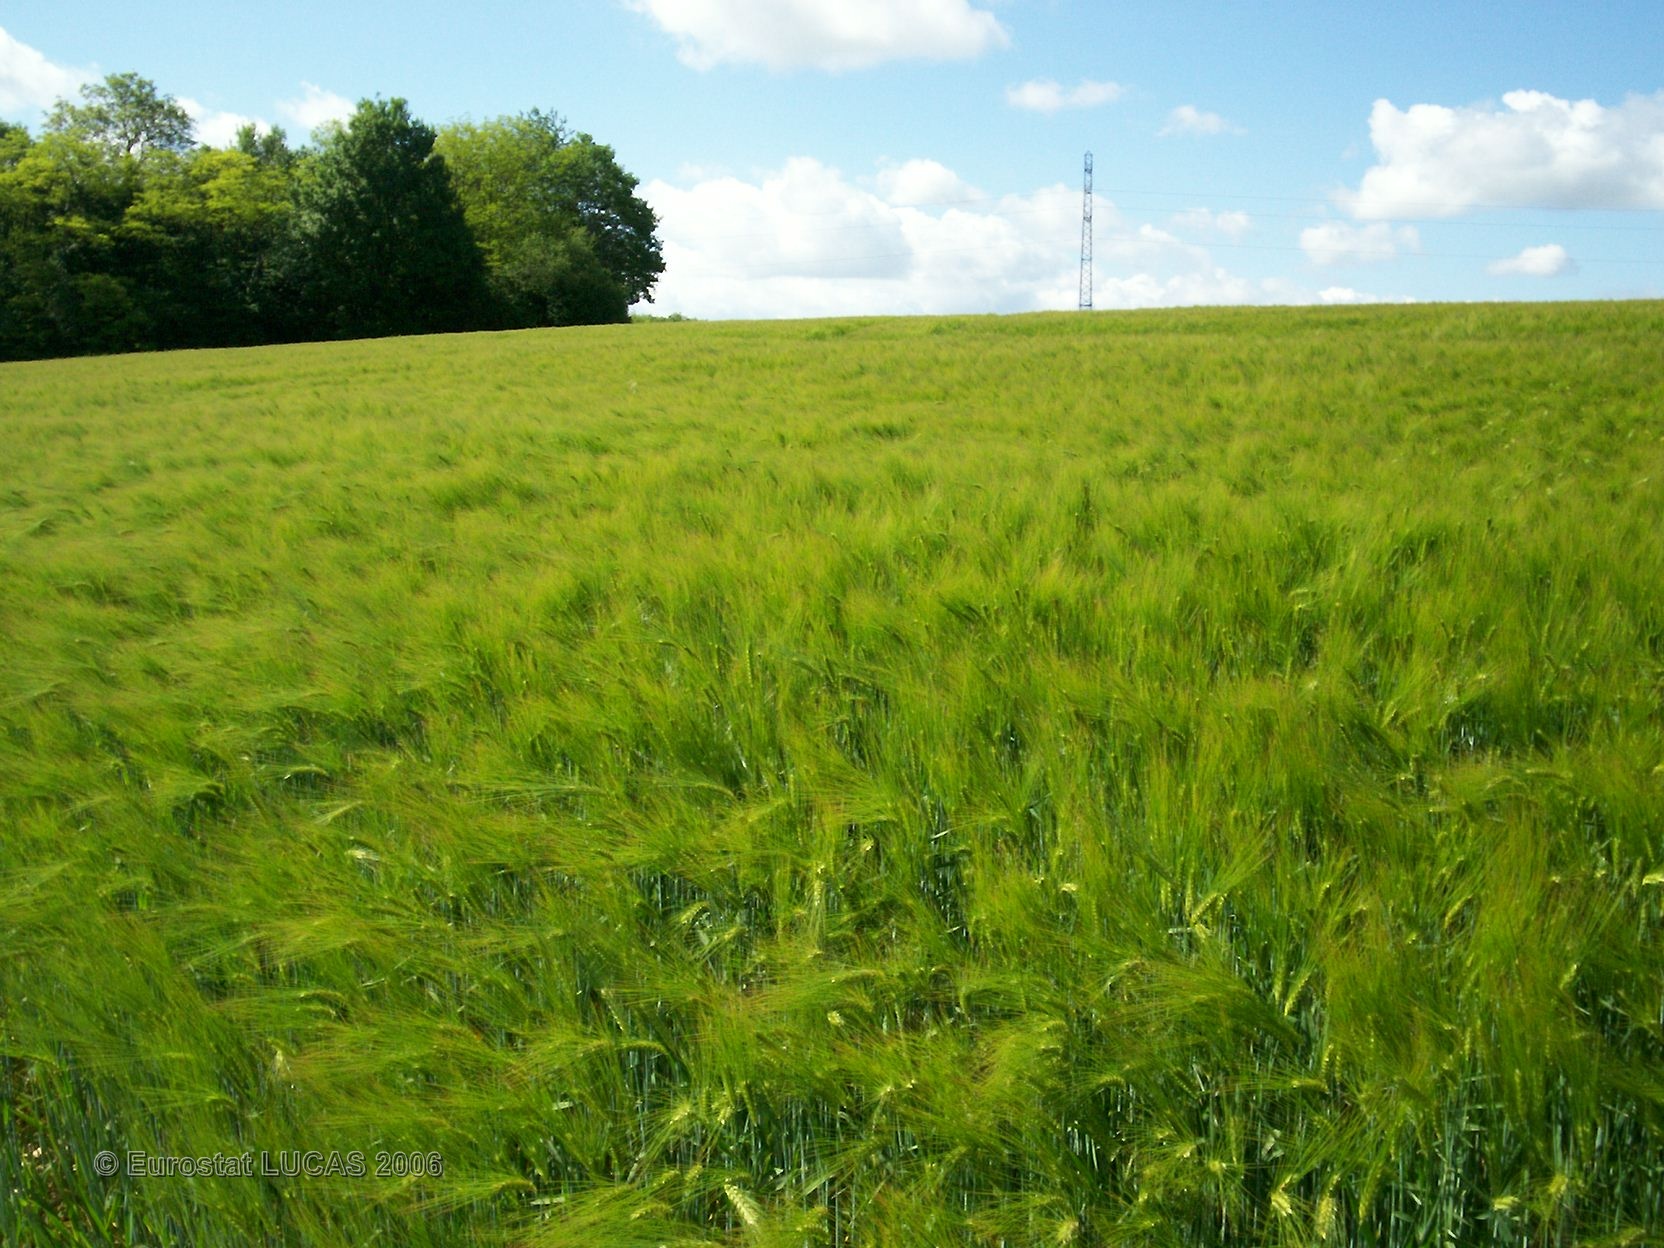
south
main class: Cropland
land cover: Barley
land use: Agriculture (excluding fallow land and kitchen gardens)
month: May
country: FR
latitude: 48.1777
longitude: 4.5242
